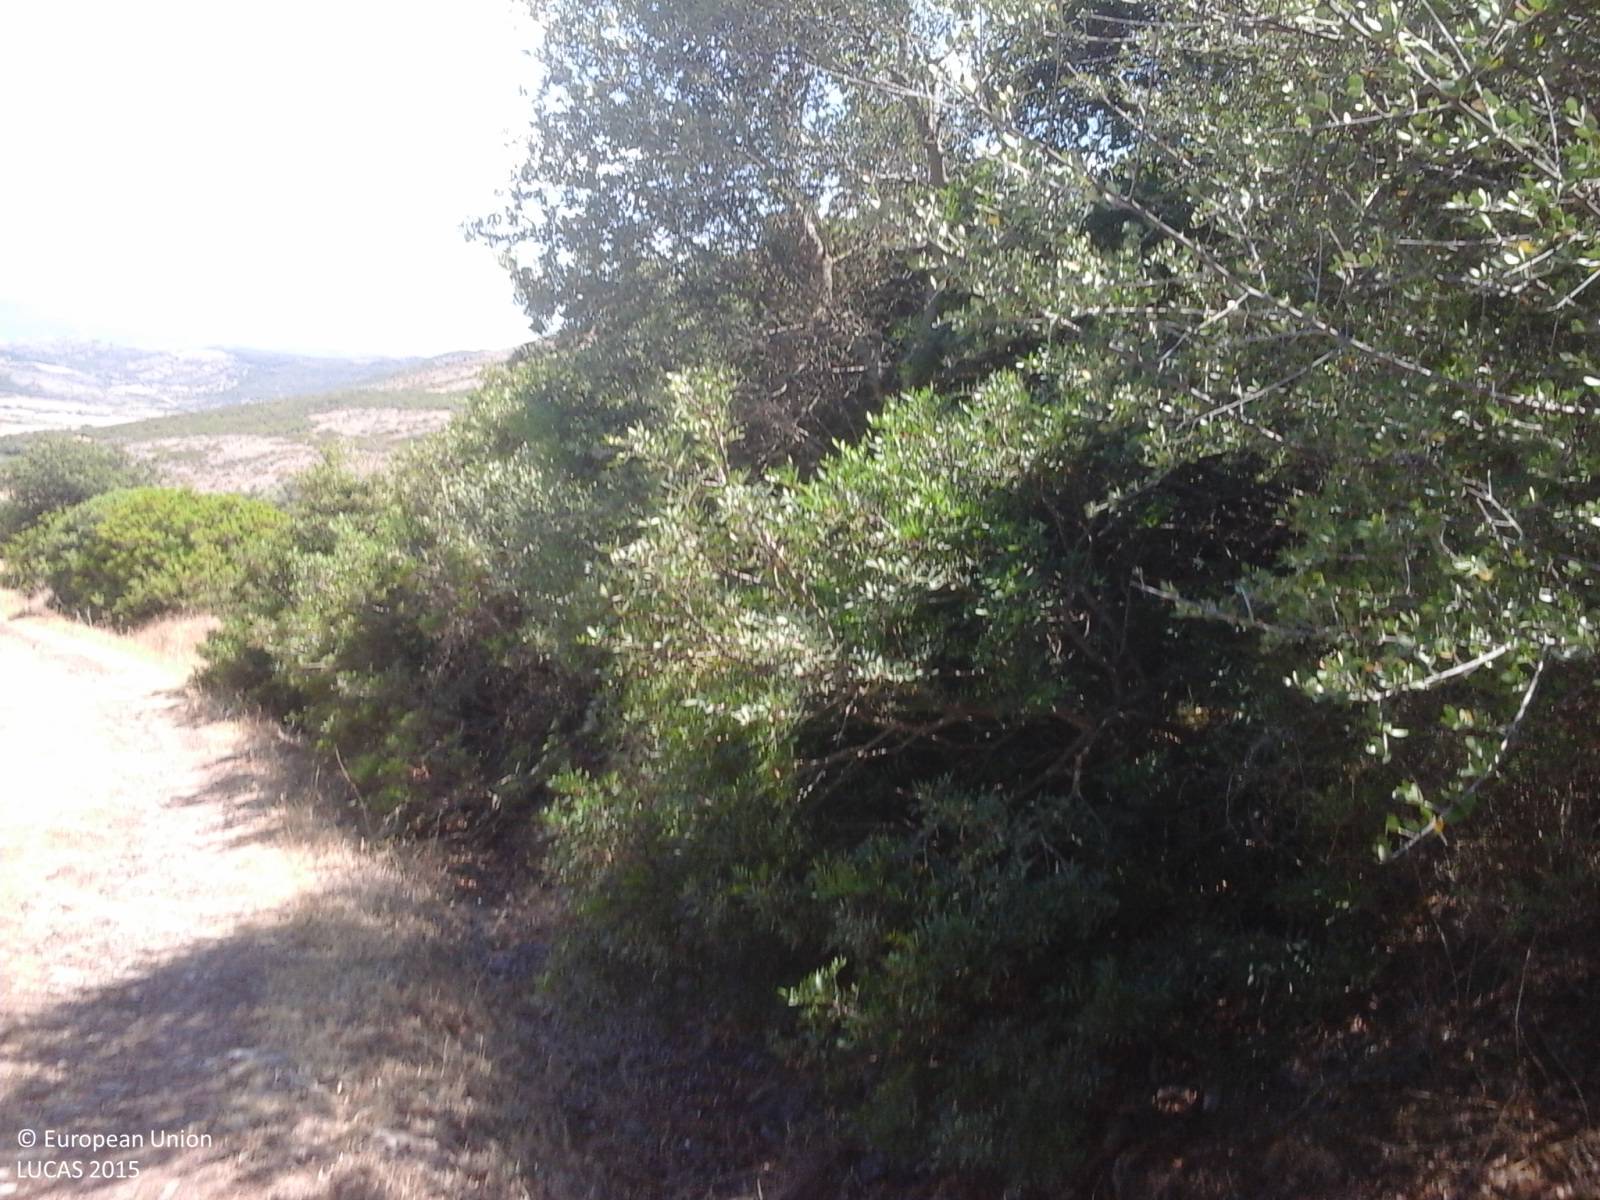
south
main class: Shrubland
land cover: Shrubland without tree cover
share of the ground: > 75 %
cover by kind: shrubs 55 %, unconsolidated bare surface 30 %, herbaceous plants 15 %
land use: Semi-natural and natural areas not in use
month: July
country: IT
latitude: 39.1521
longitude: 8.5856
